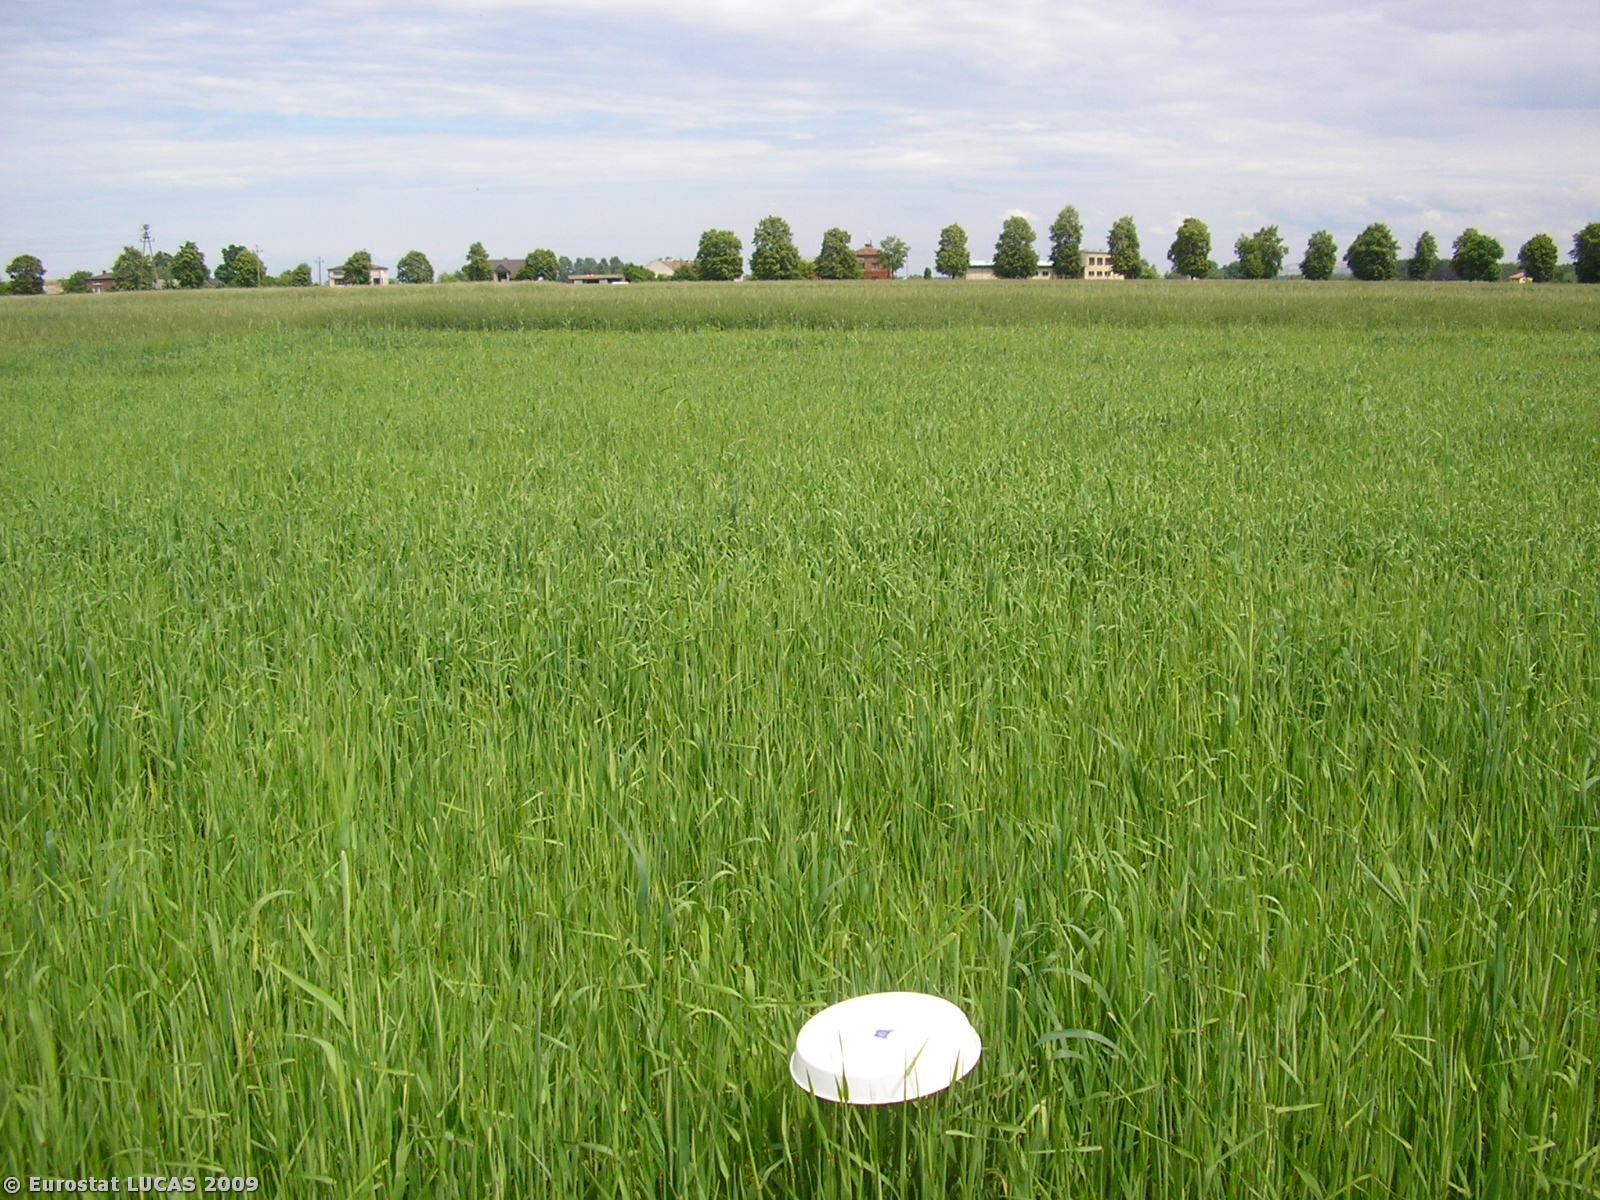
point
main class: Cropland
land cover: Barley
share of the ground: > 75 %
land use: Agriculture (excluding fallow land and kitchen gardens)
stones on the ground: 10 - 25 %
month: June
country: PL
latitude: 51.2988
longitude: 18.9293
